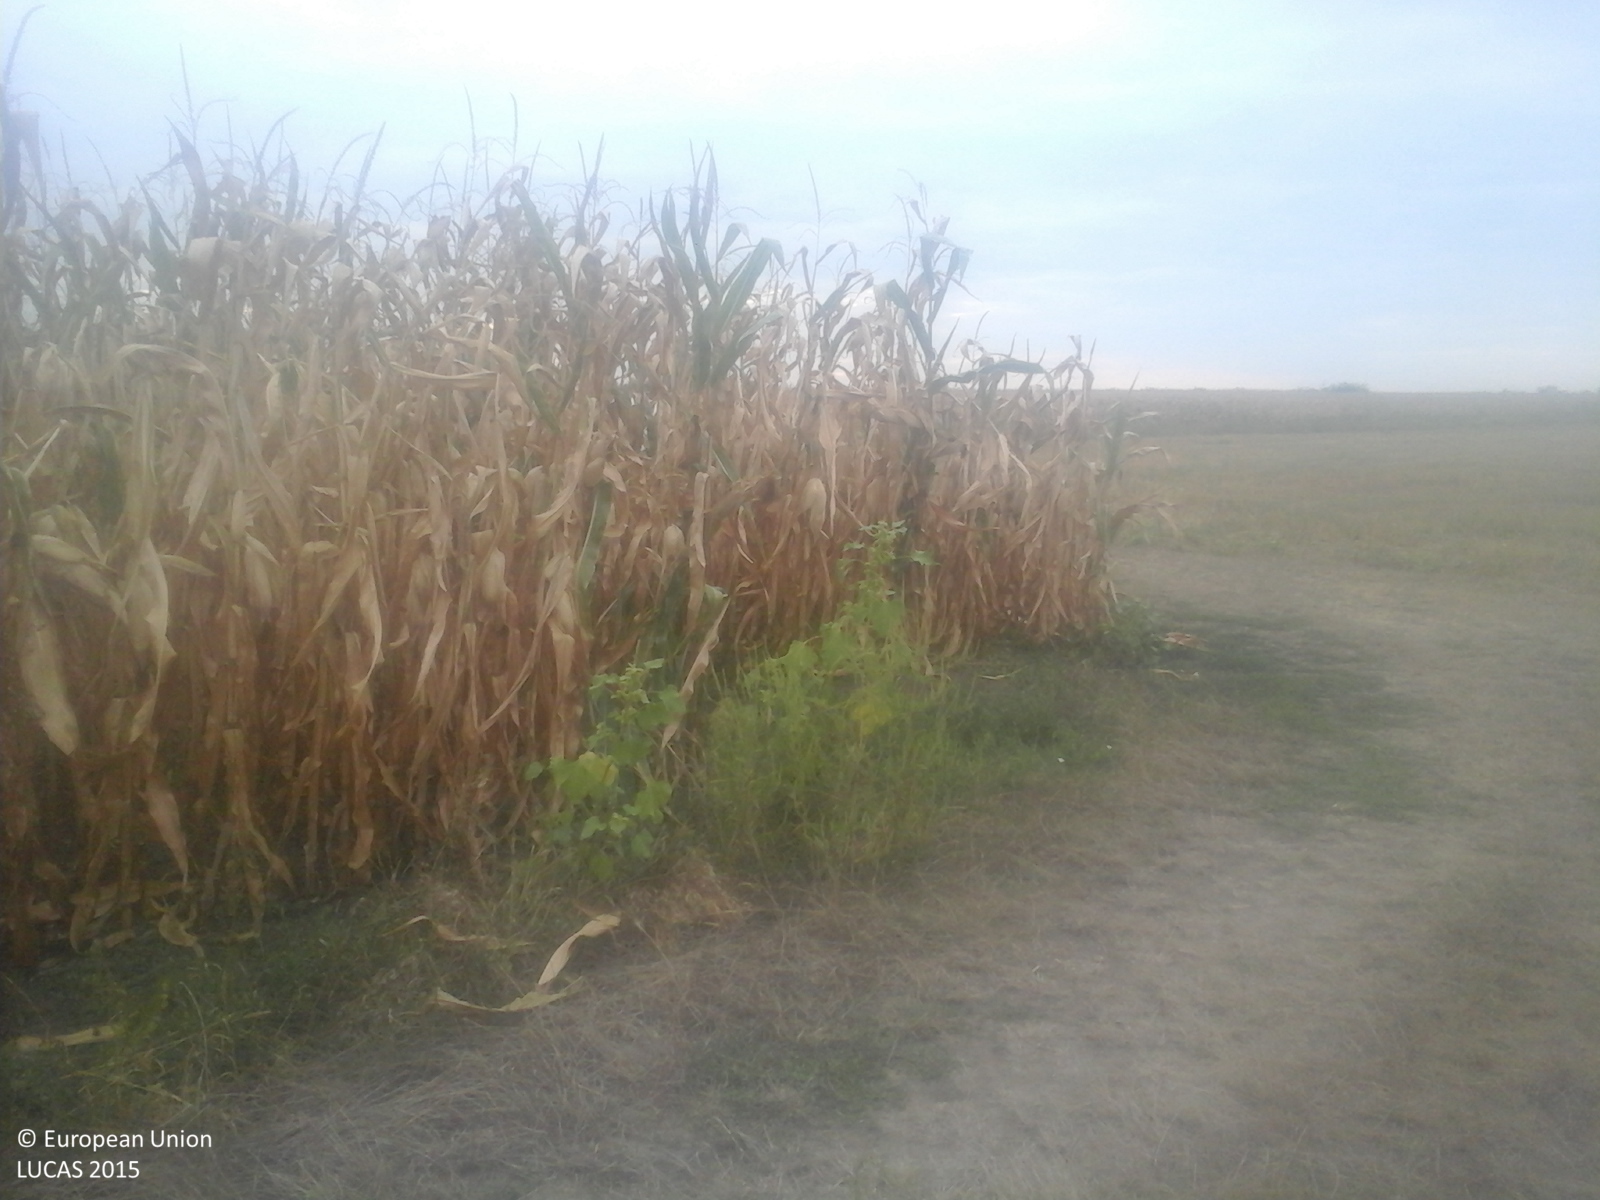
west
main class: Cropland
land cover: Sunflower
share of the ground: > 75 %
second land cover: Spontaneously vegetated surfaces
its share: > 75 %
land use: Agriculture (excluding fallow land and kitchen gardens)
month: September
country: RO
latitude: 47.7415
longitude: 22.6908
